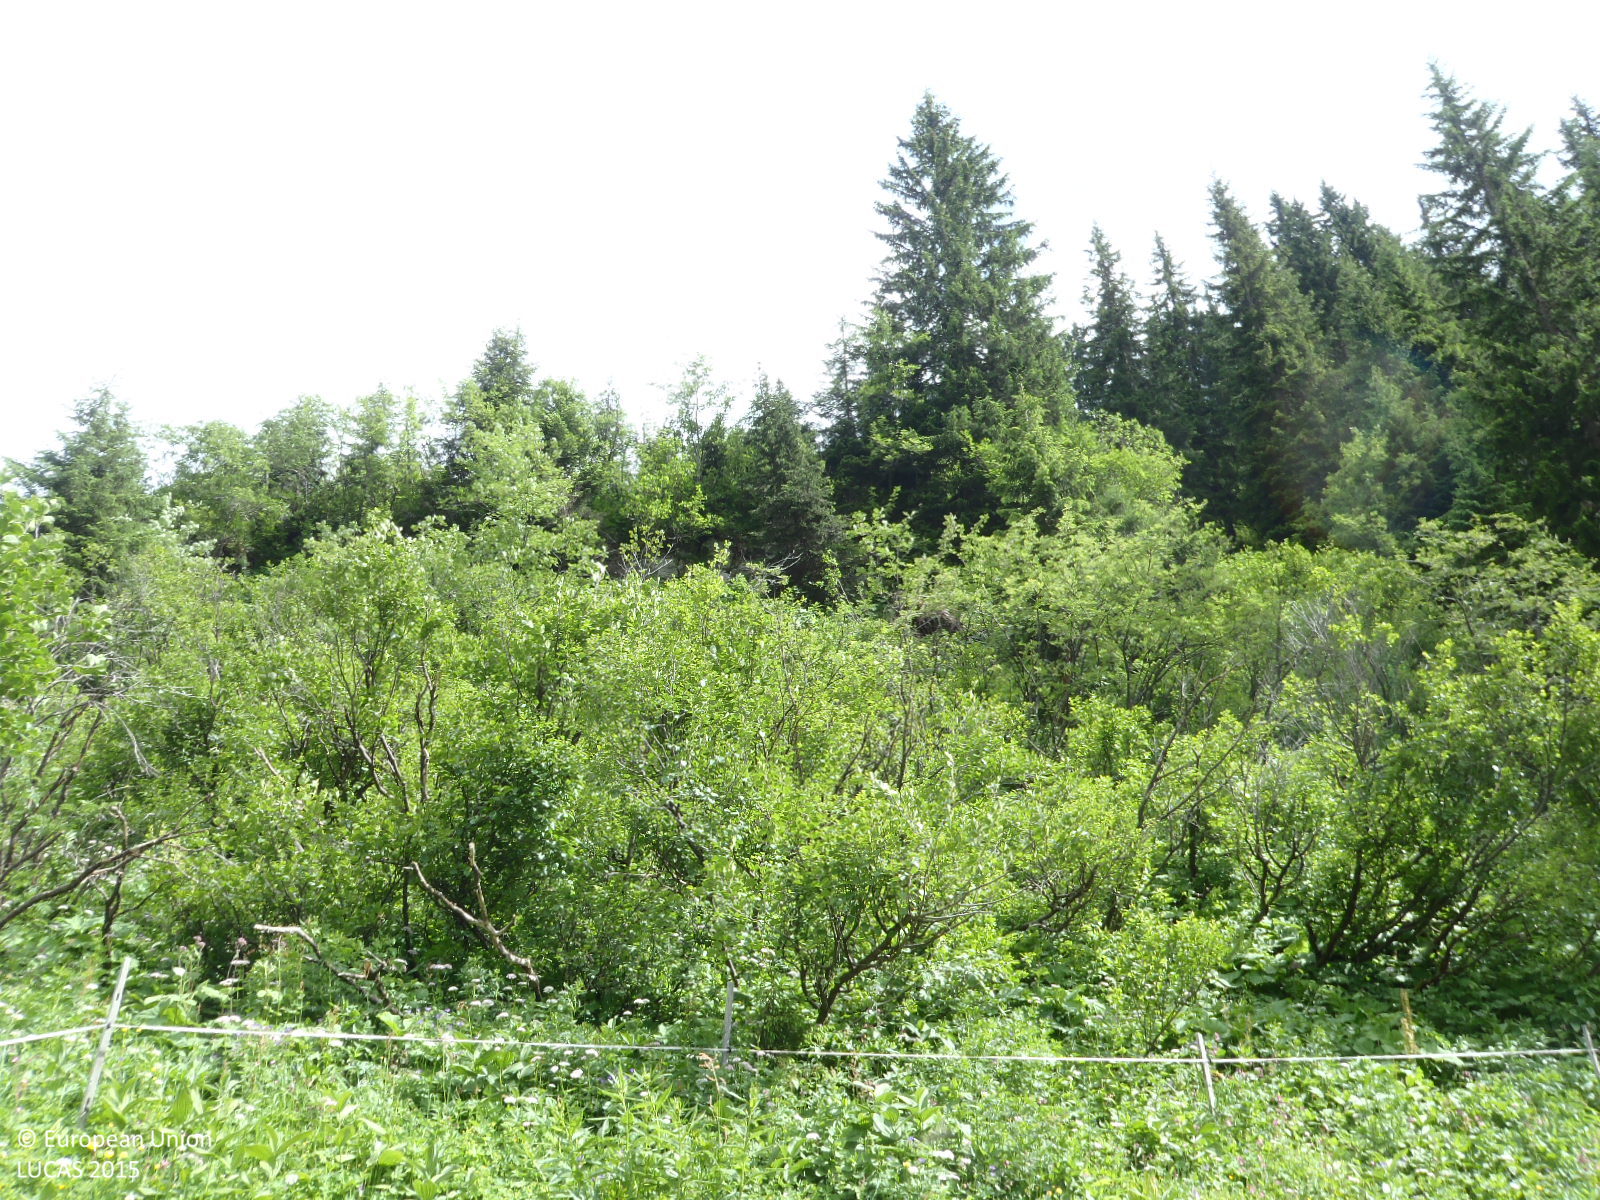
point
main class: Shrubland
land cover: Shrubland with sparse tree cover
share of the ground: > 75 %
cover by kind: shrubs 95 %, coniferous forest trees 5 %
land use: Semi-natural and natural areas not in use
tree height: > 5 m
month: June
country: AT
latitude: 47.2334
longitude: 10.1715
